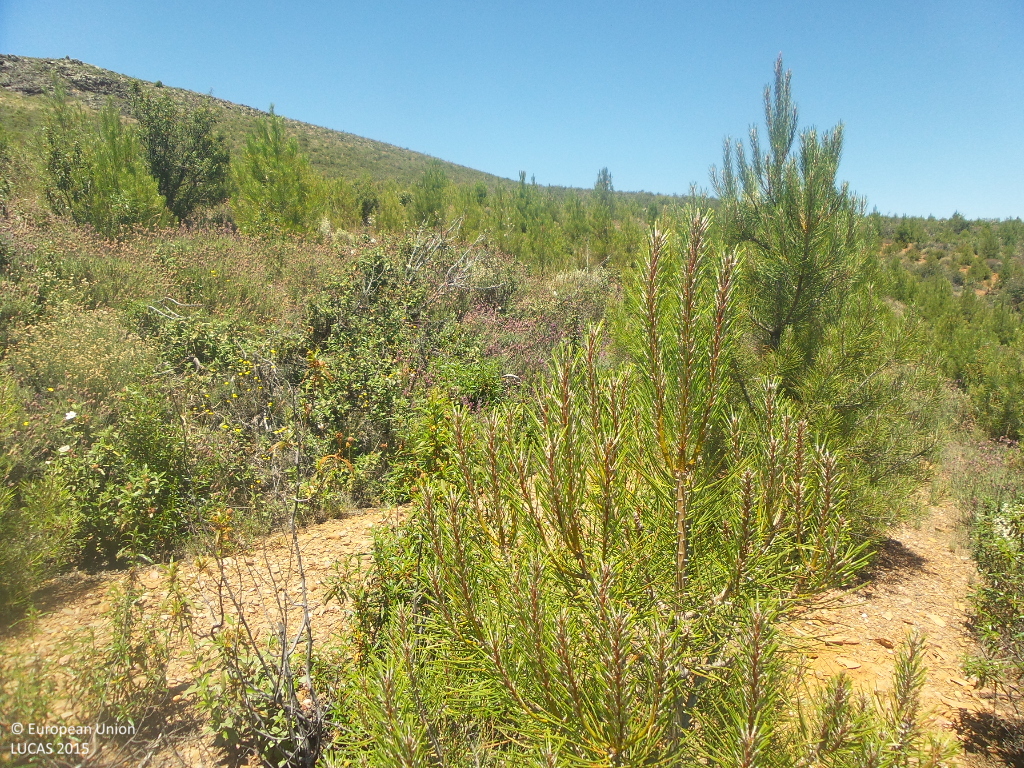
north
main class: Woodland
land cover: Pine dominated coniferous woodland
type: coniferous forest of the mediterranean region
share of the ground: 10 - 25 %
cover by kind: shrubs 60 %, coniferous forest trees 20 %, unconsolidated bare surface 20 %
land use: Forestry
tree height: < 5 m
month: June
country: ES
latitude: 41.1440
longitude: -2.9401
